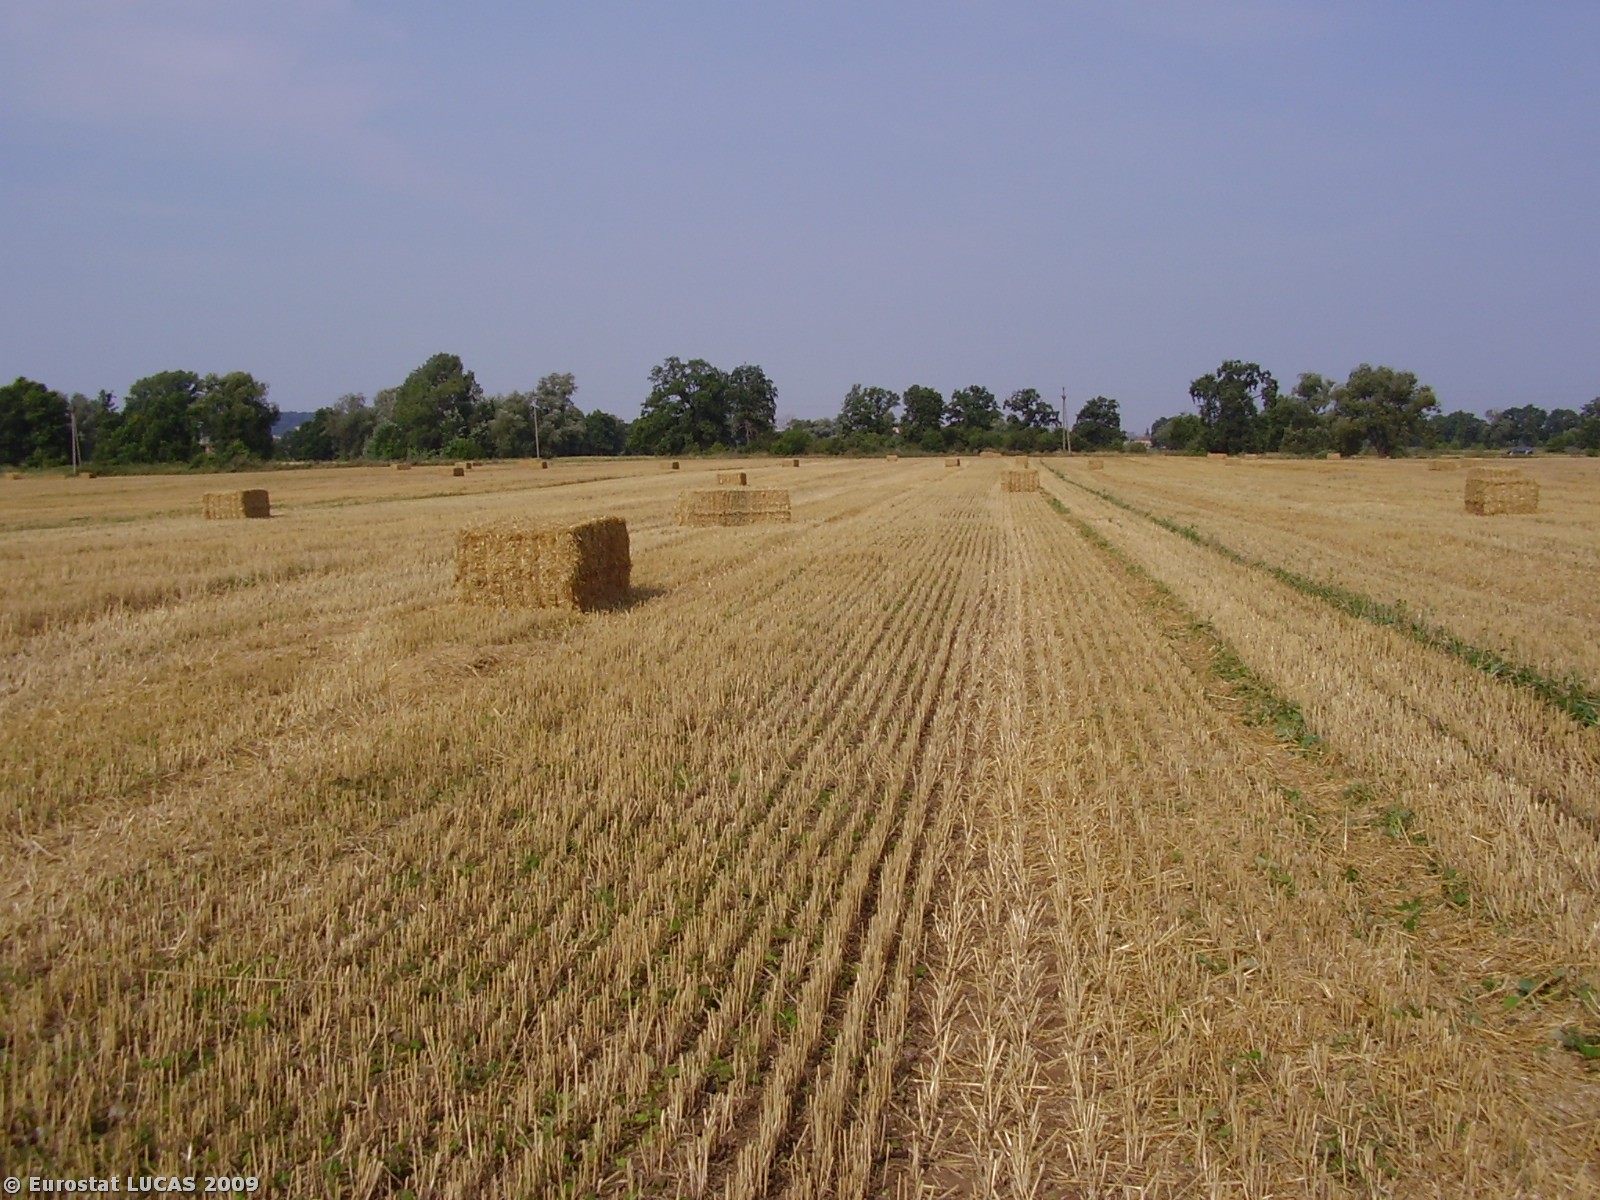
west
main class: Cropland
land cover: Common wheat
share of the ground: < 10 %
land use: Agriculture (excluding fallow land and kitchen gardens)
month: August
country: PL
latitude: 51.6397
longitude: 16.1766
